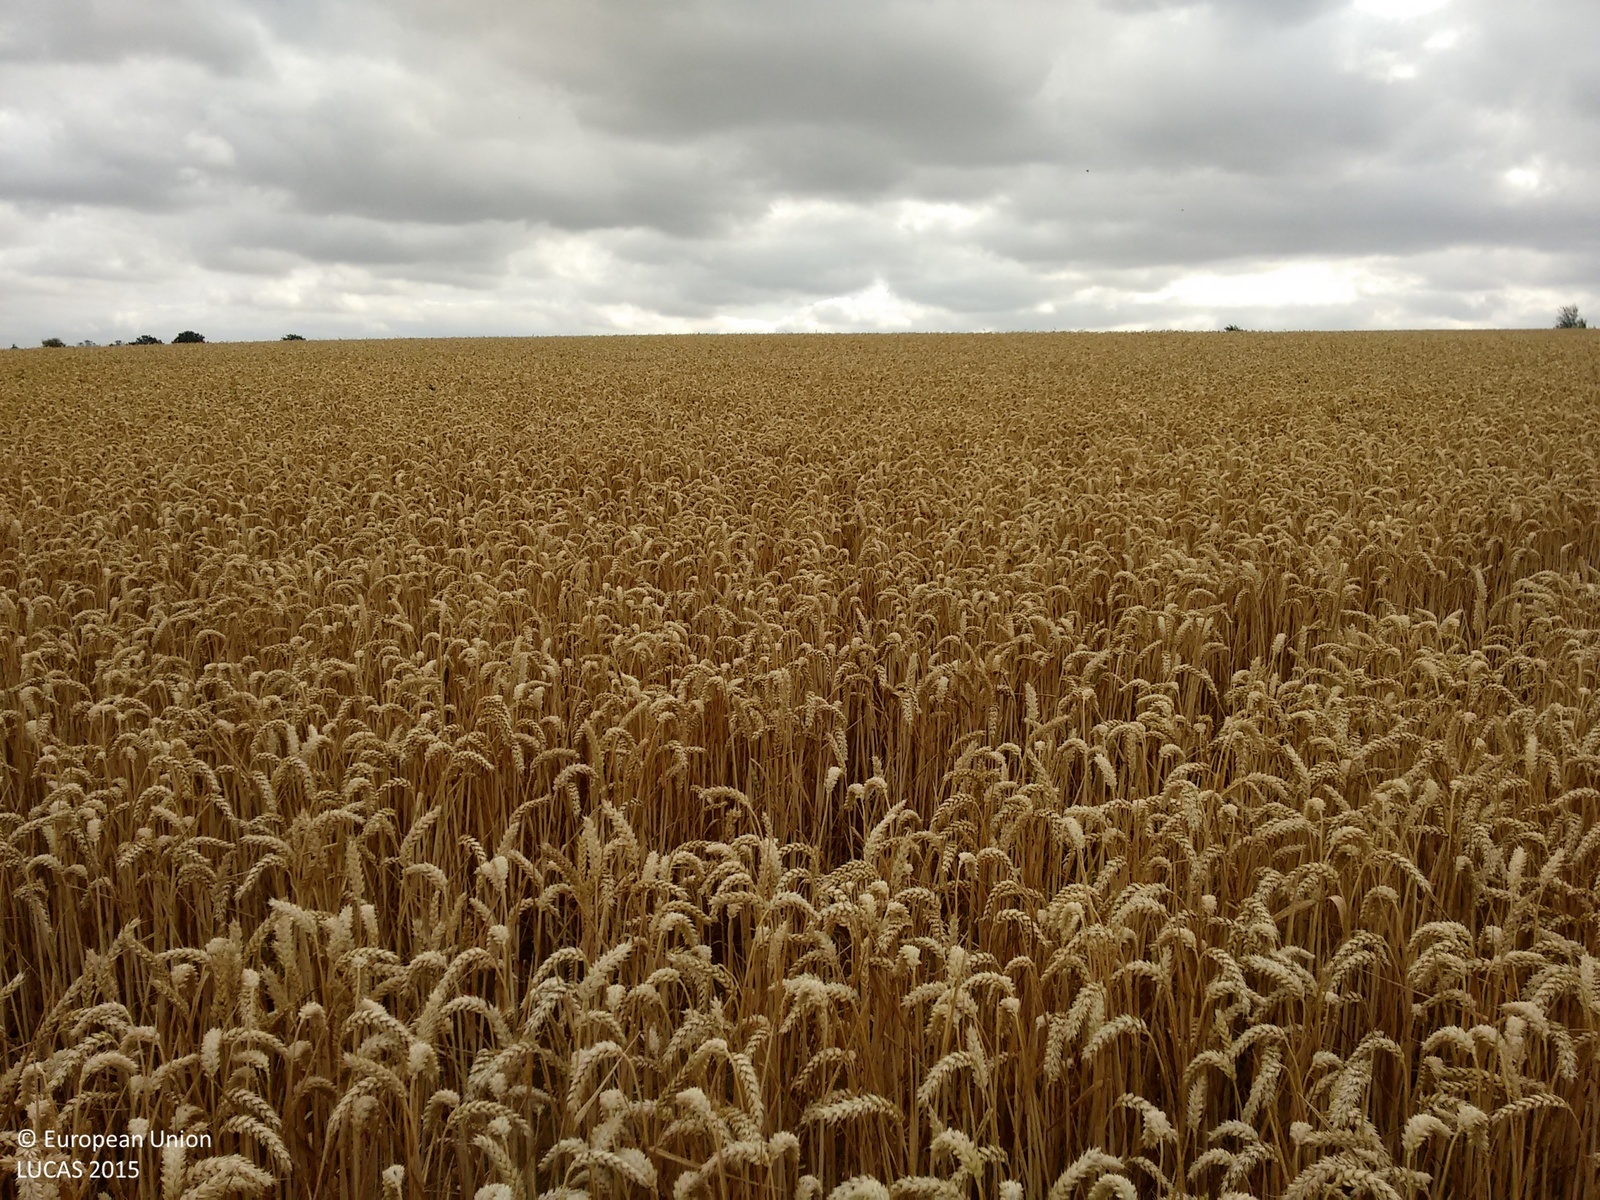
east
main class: Cropland
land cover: Common wheat
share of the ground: > 75 %
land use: Agriculture (excluding fallow land and kitchen gardens)
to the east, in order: Common wheat; Tracks; Dry pulses
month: August
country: GB
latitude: 51.9476
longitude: 0.3541
